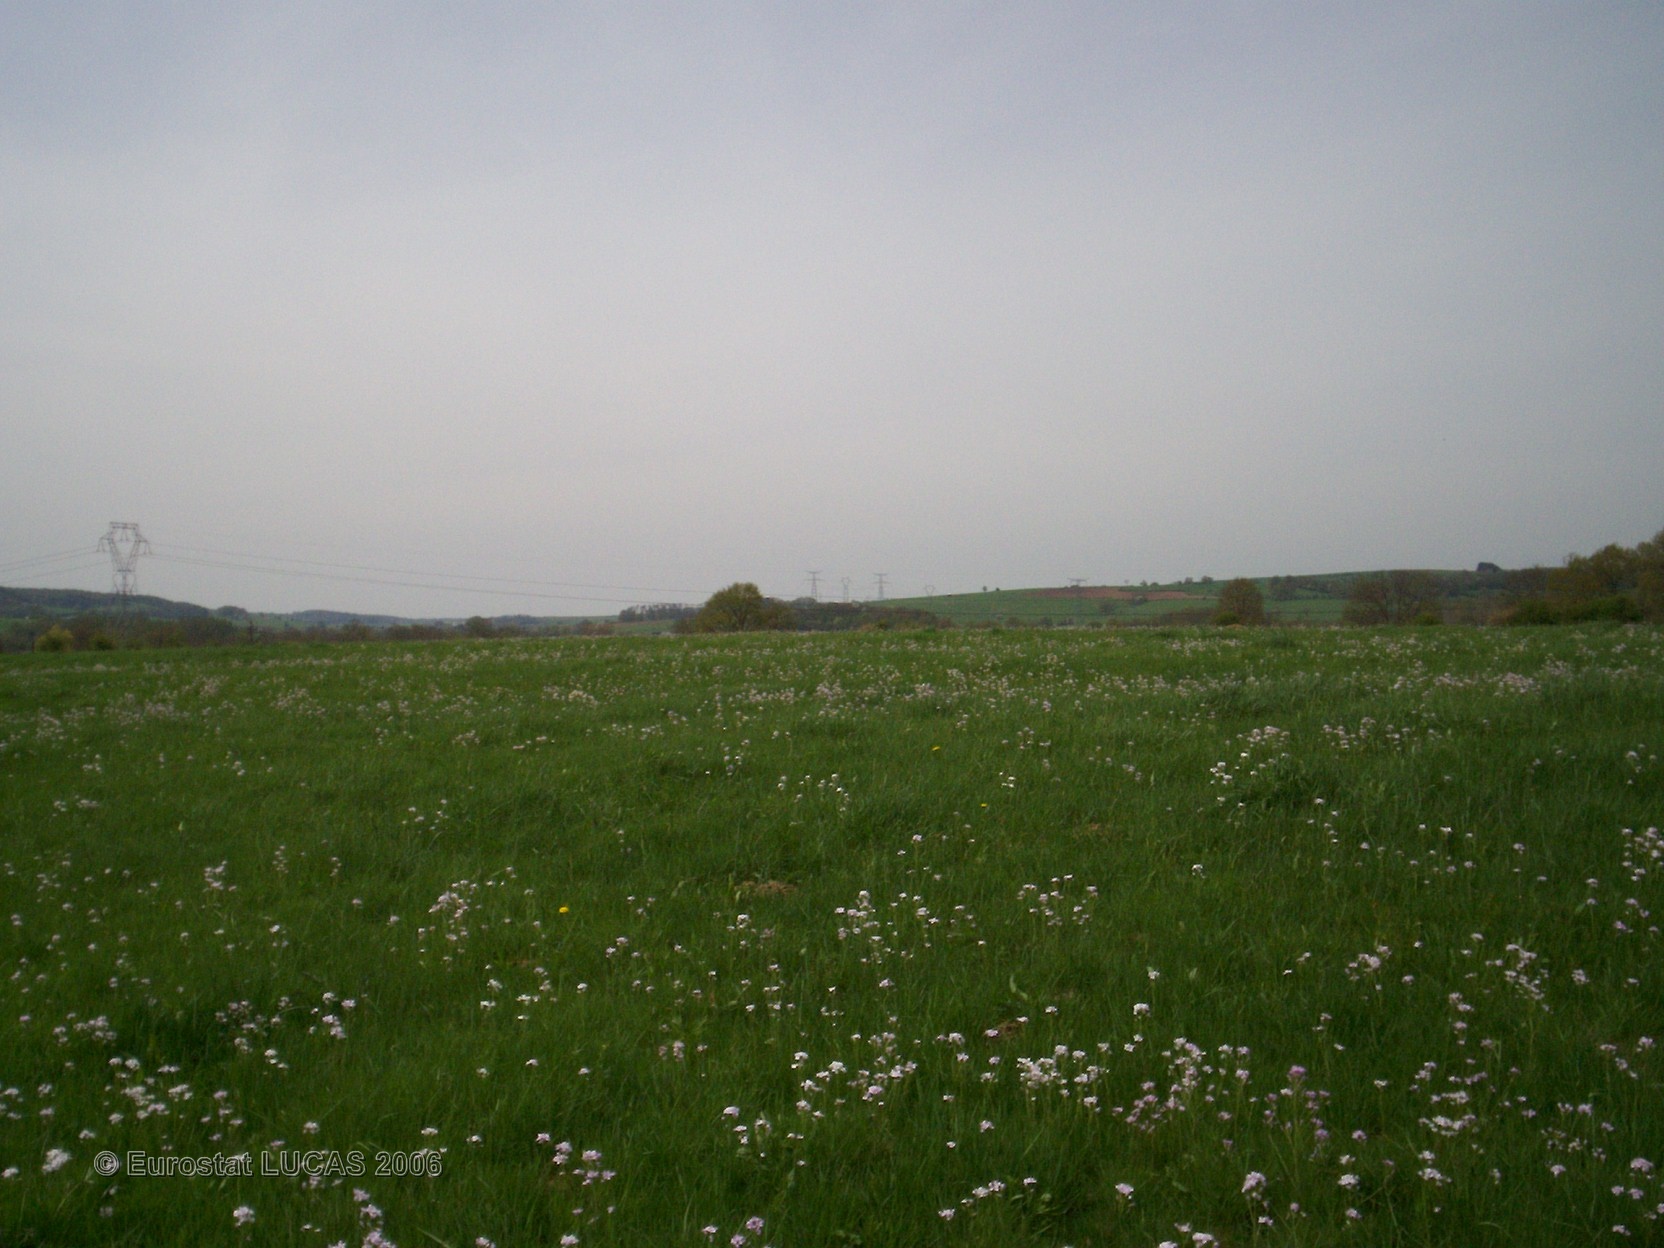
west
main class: Grassland
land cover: Grassland without tree/shrub cover
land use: Agriculture (excluding fallow land and kitchen gardens)
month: May
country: FR
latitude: 49.8009
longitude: 4.5360
